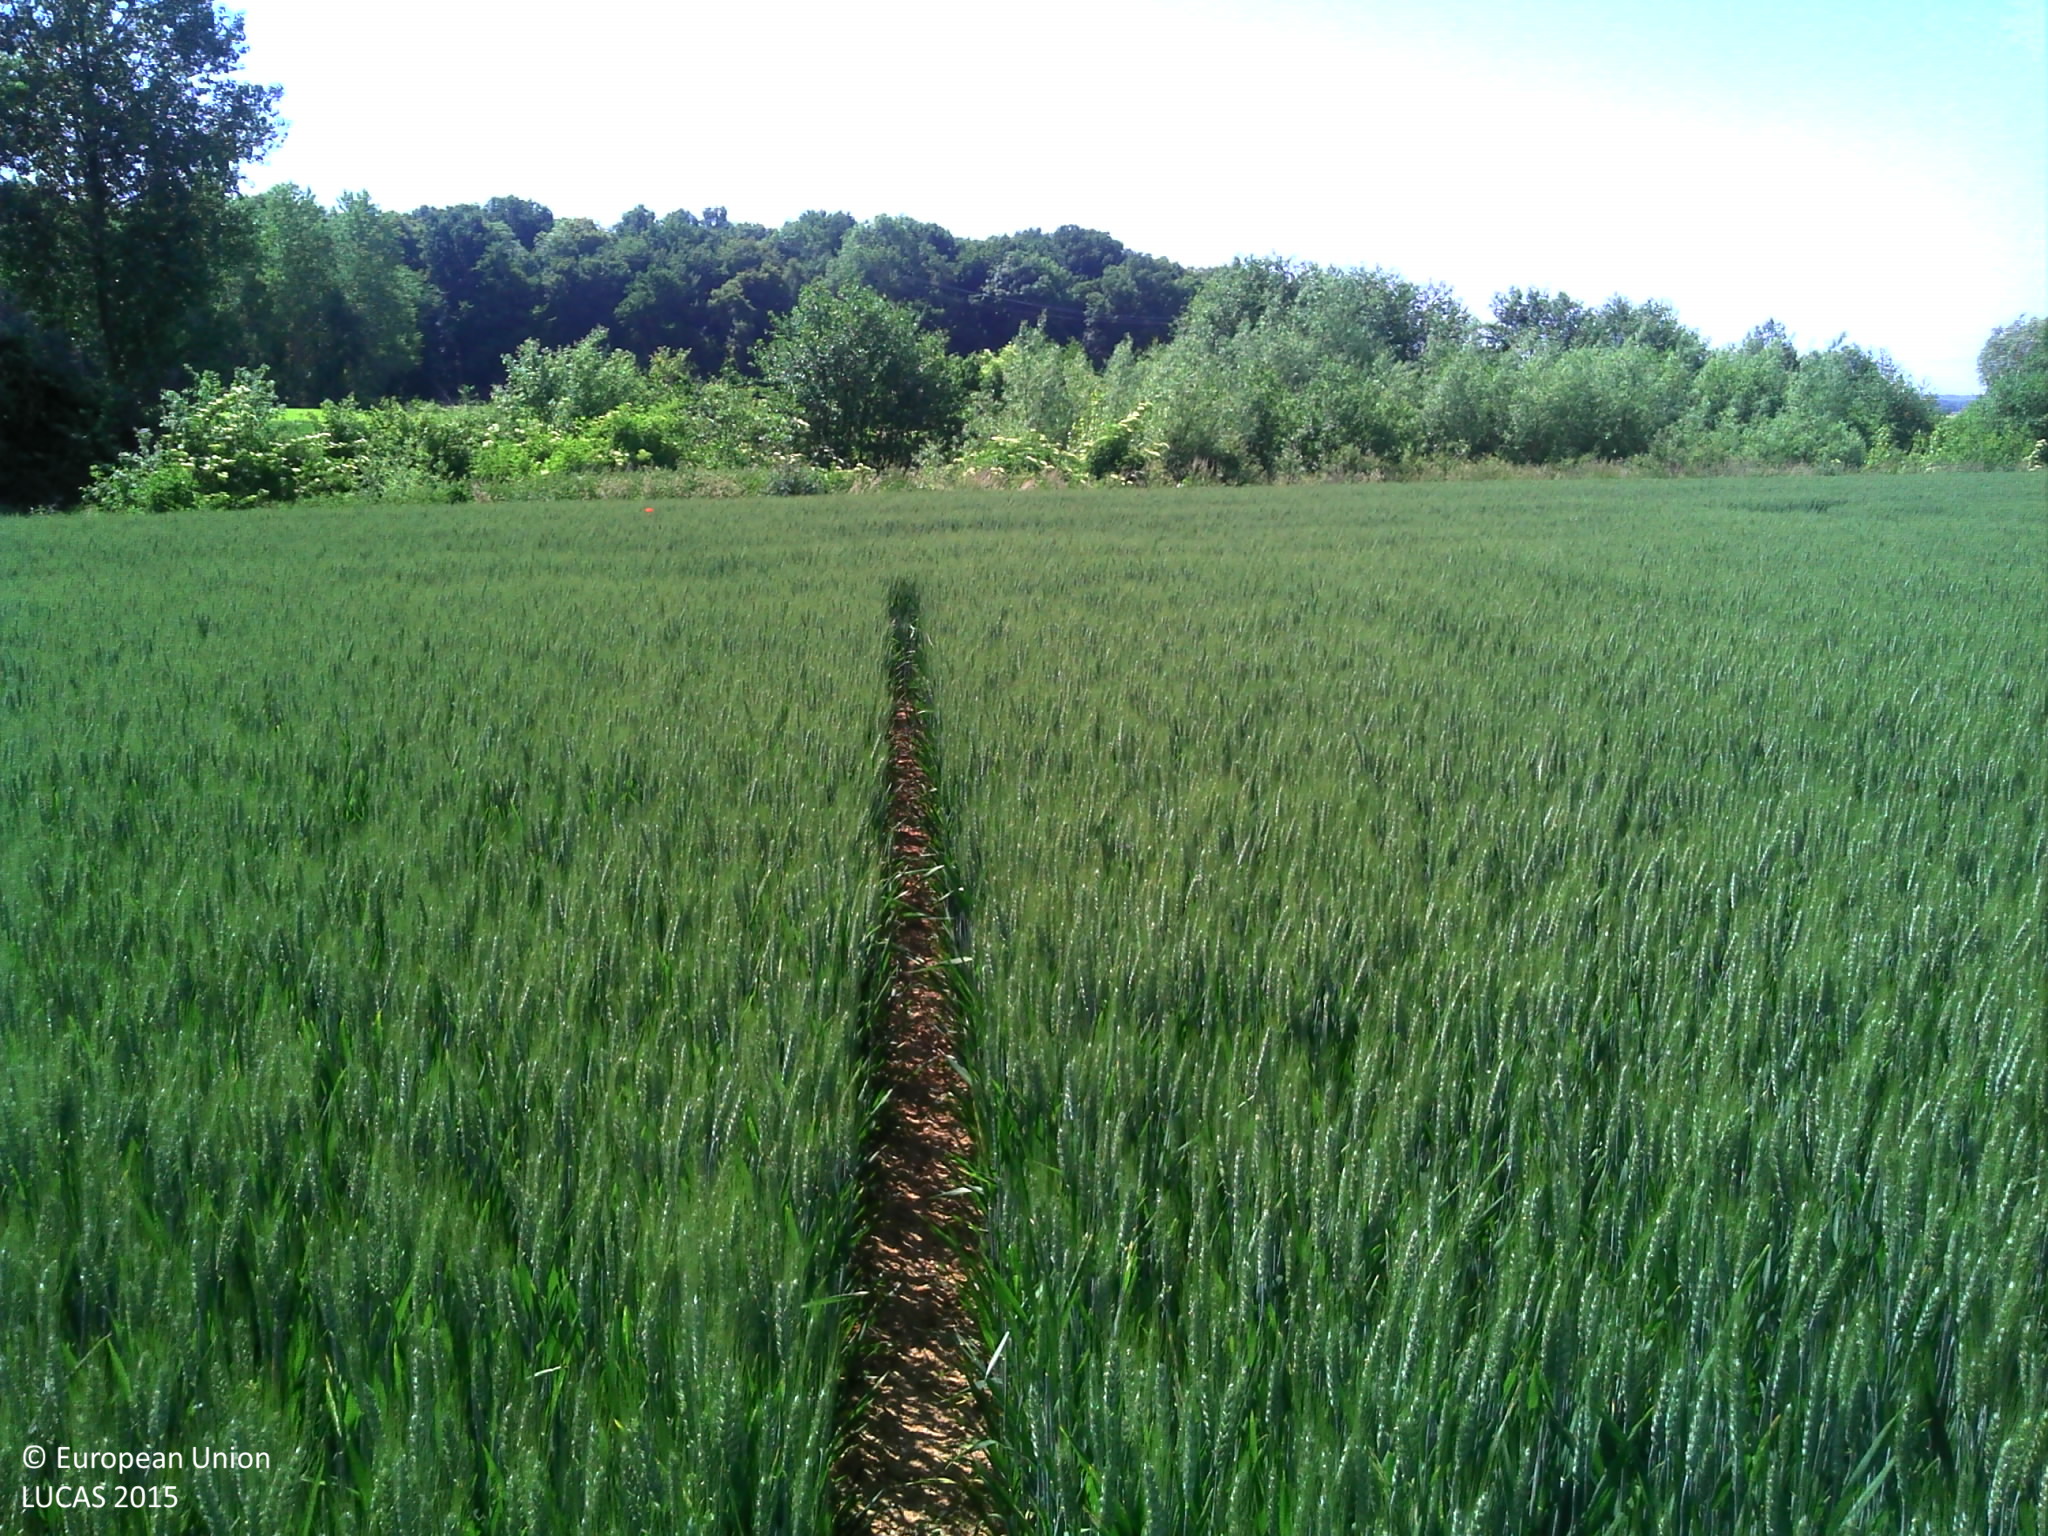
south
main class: Cropland
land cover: Common wheat
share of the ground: > 75 %
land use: Agriculture (excluding fallow land and kitchen gardens)
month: June
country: FR
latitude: 49.5695
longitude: 3.2577
